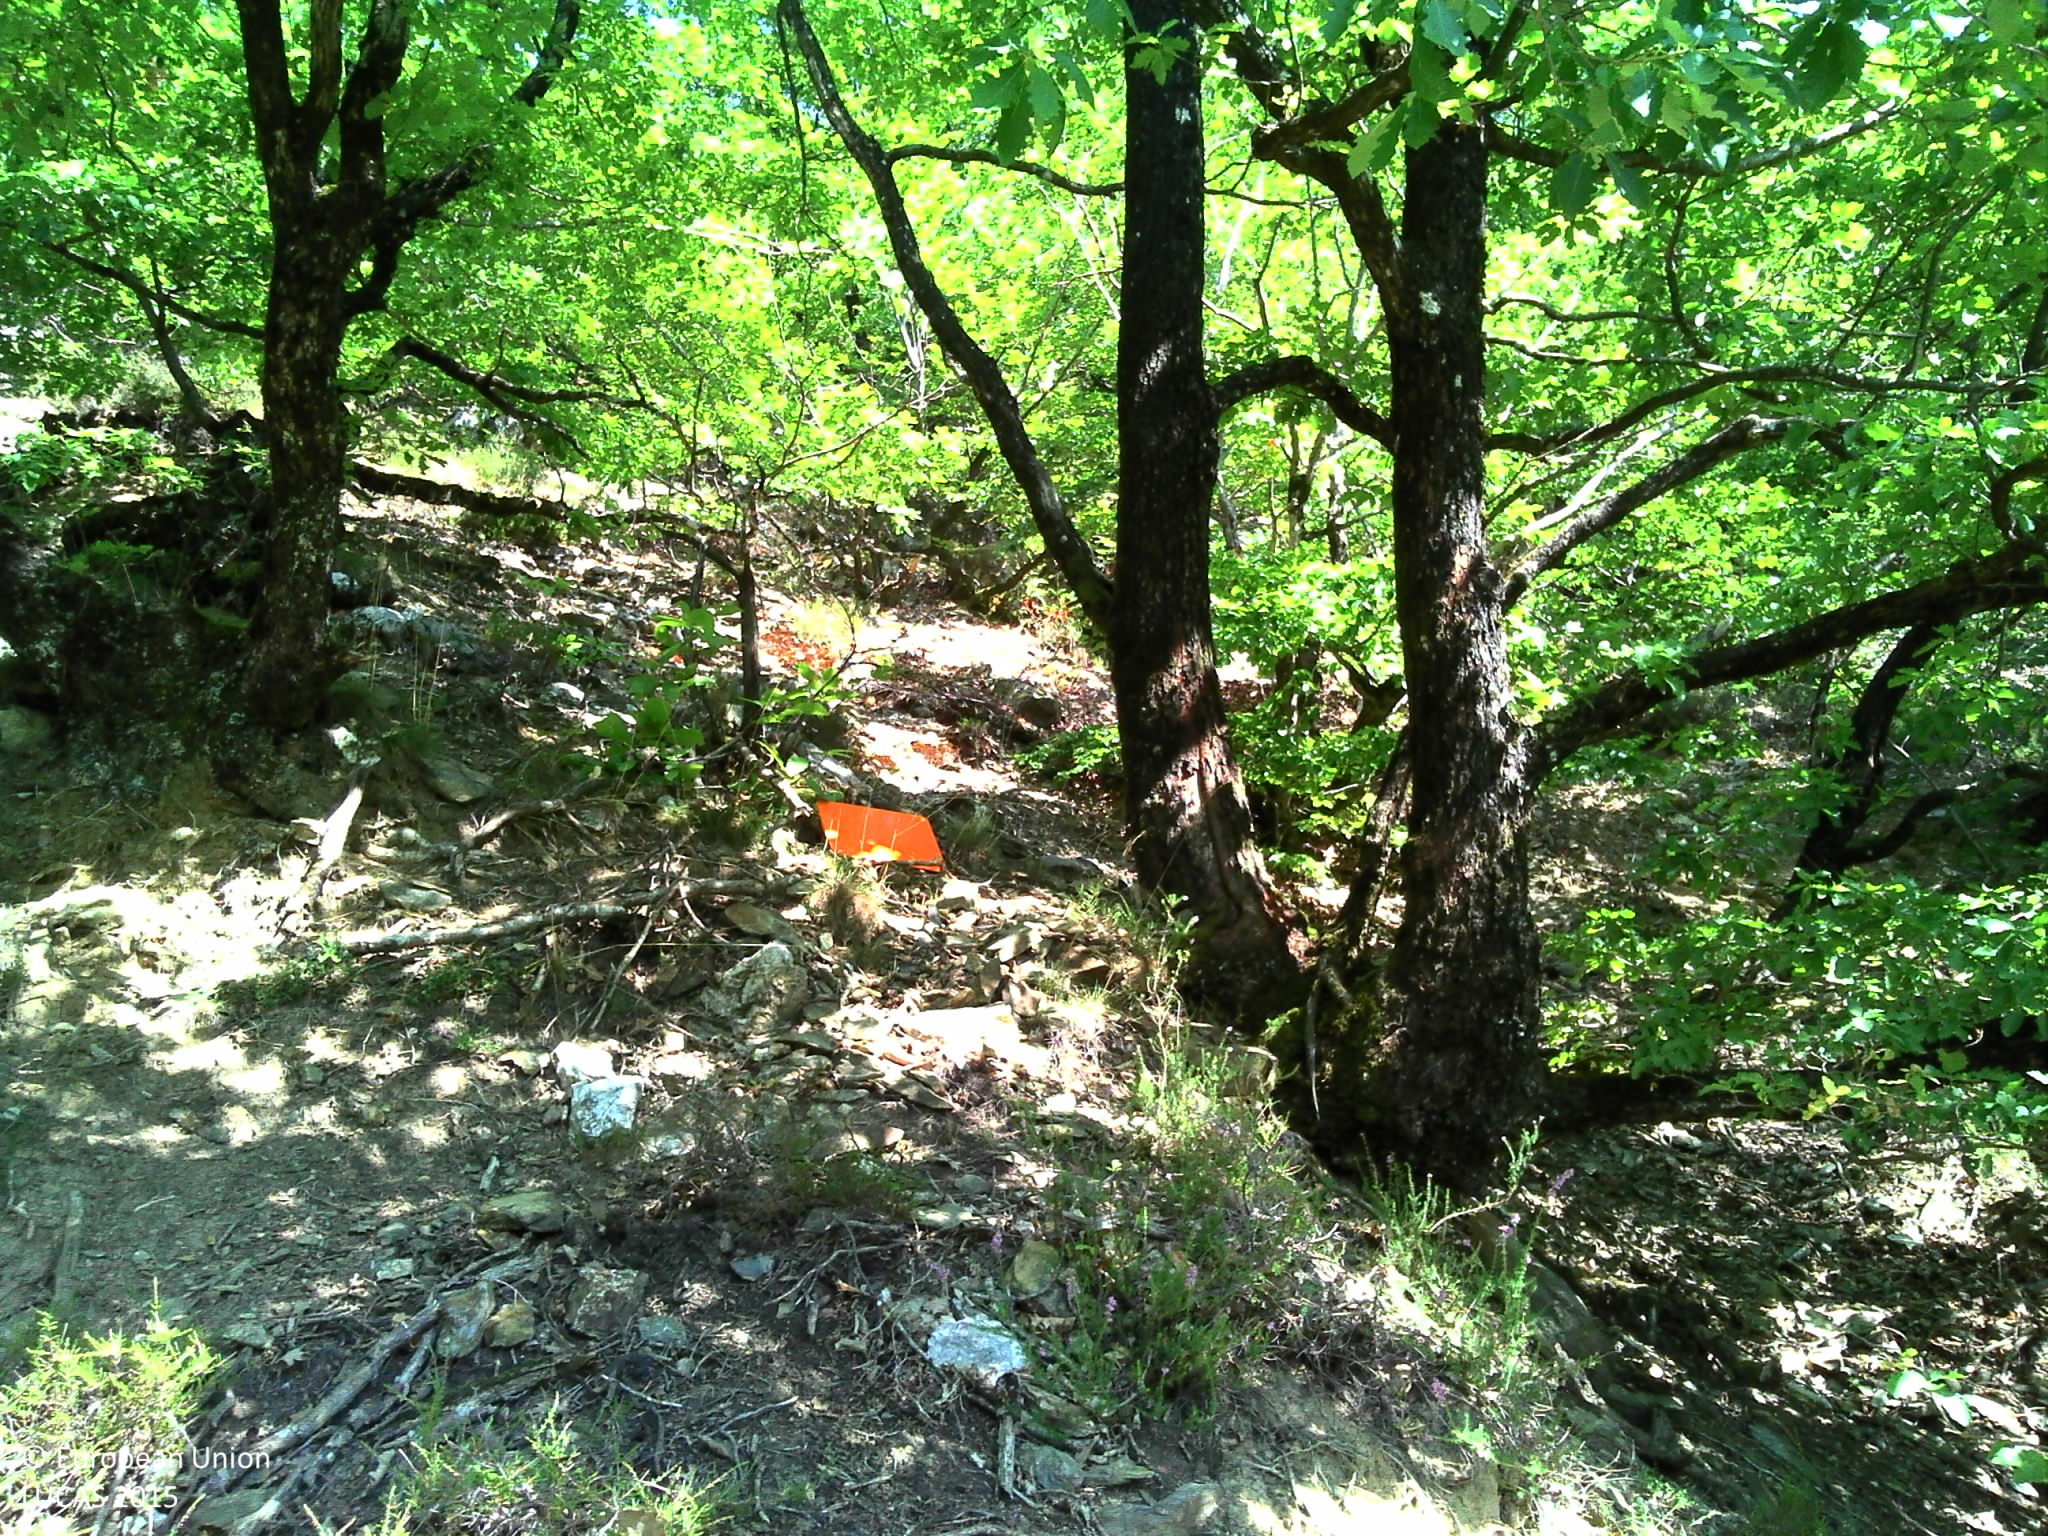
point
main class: Woodland
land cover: Broadleaved woodland
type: acidophilous oak and oak-birch forest
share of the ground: > 75 %
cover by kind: broadleaved forest trees 90 %, herbaceous plants 5 %, lichens and mosses 5 %
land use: Forestry
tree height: > 5 m
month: August
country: FR
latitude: 43.7727
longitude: 3.0376
